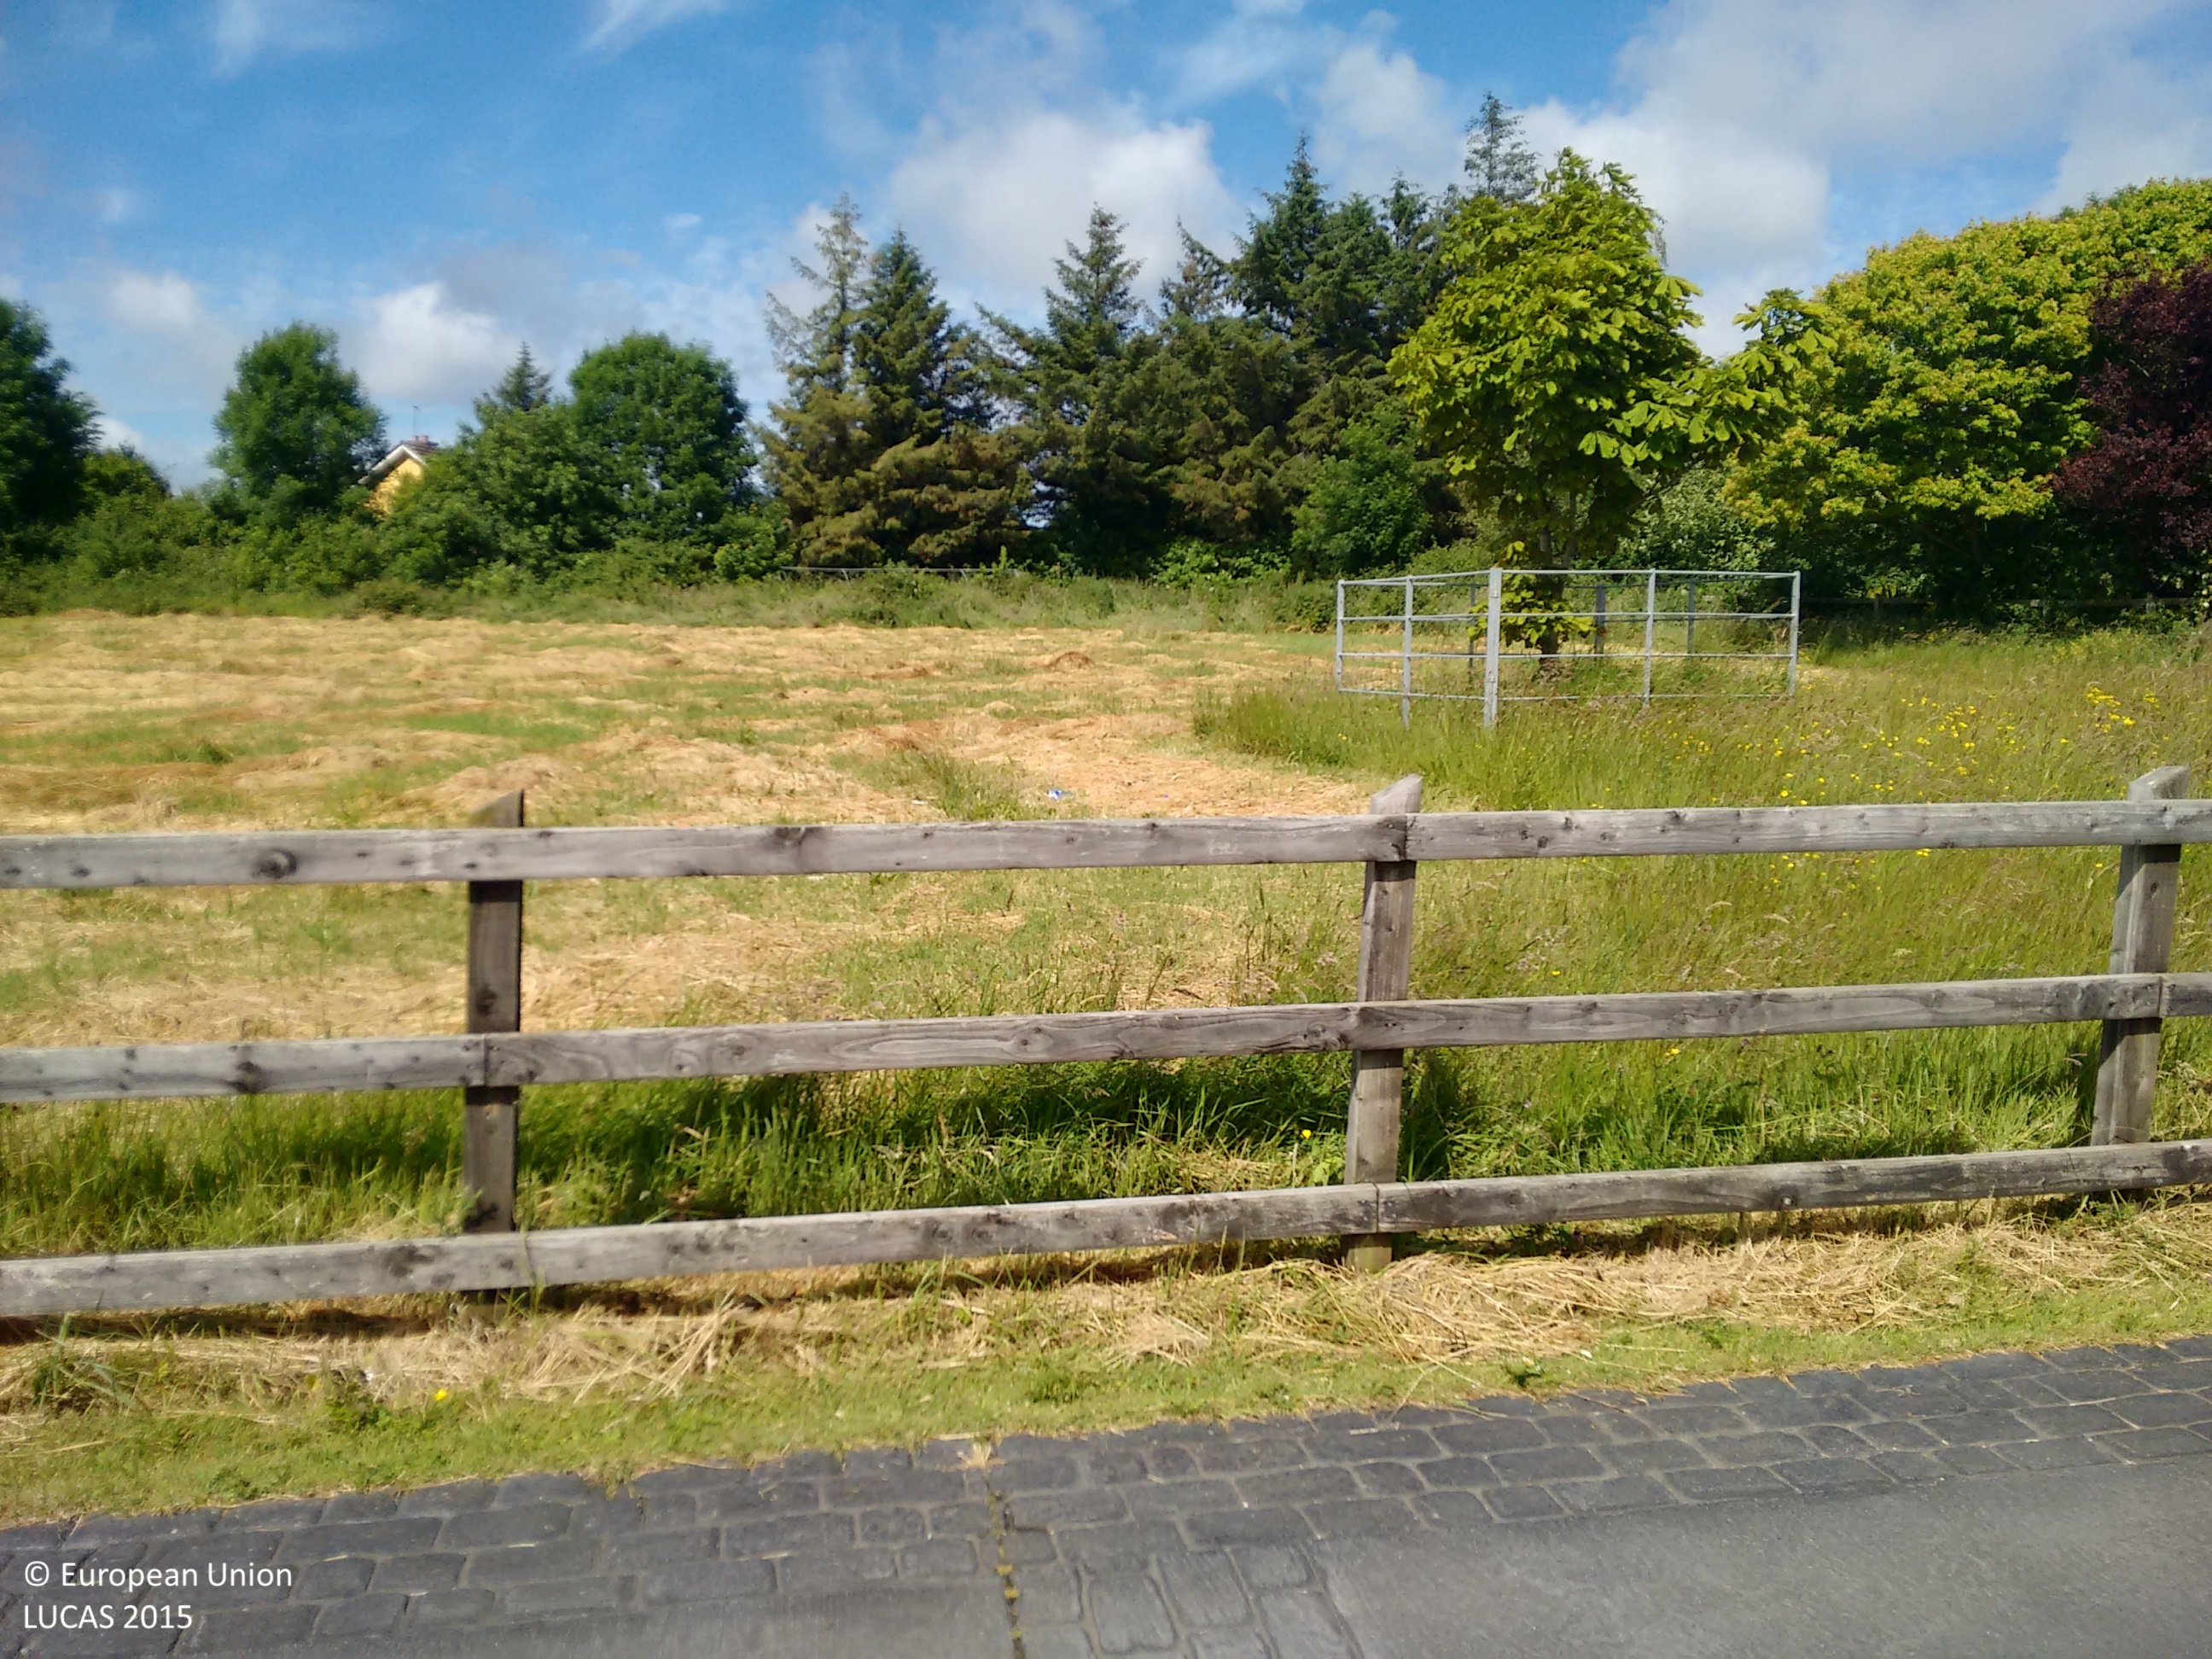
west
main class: Grassland
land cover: Grassland without tree/shrub cover
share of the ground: > 75 %
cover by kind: herbaceous plants 100 %
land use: Agriculture (excluding fallow land and kitchen gardens)
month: June
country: IE
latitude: 52.2684
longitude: -7.0703
